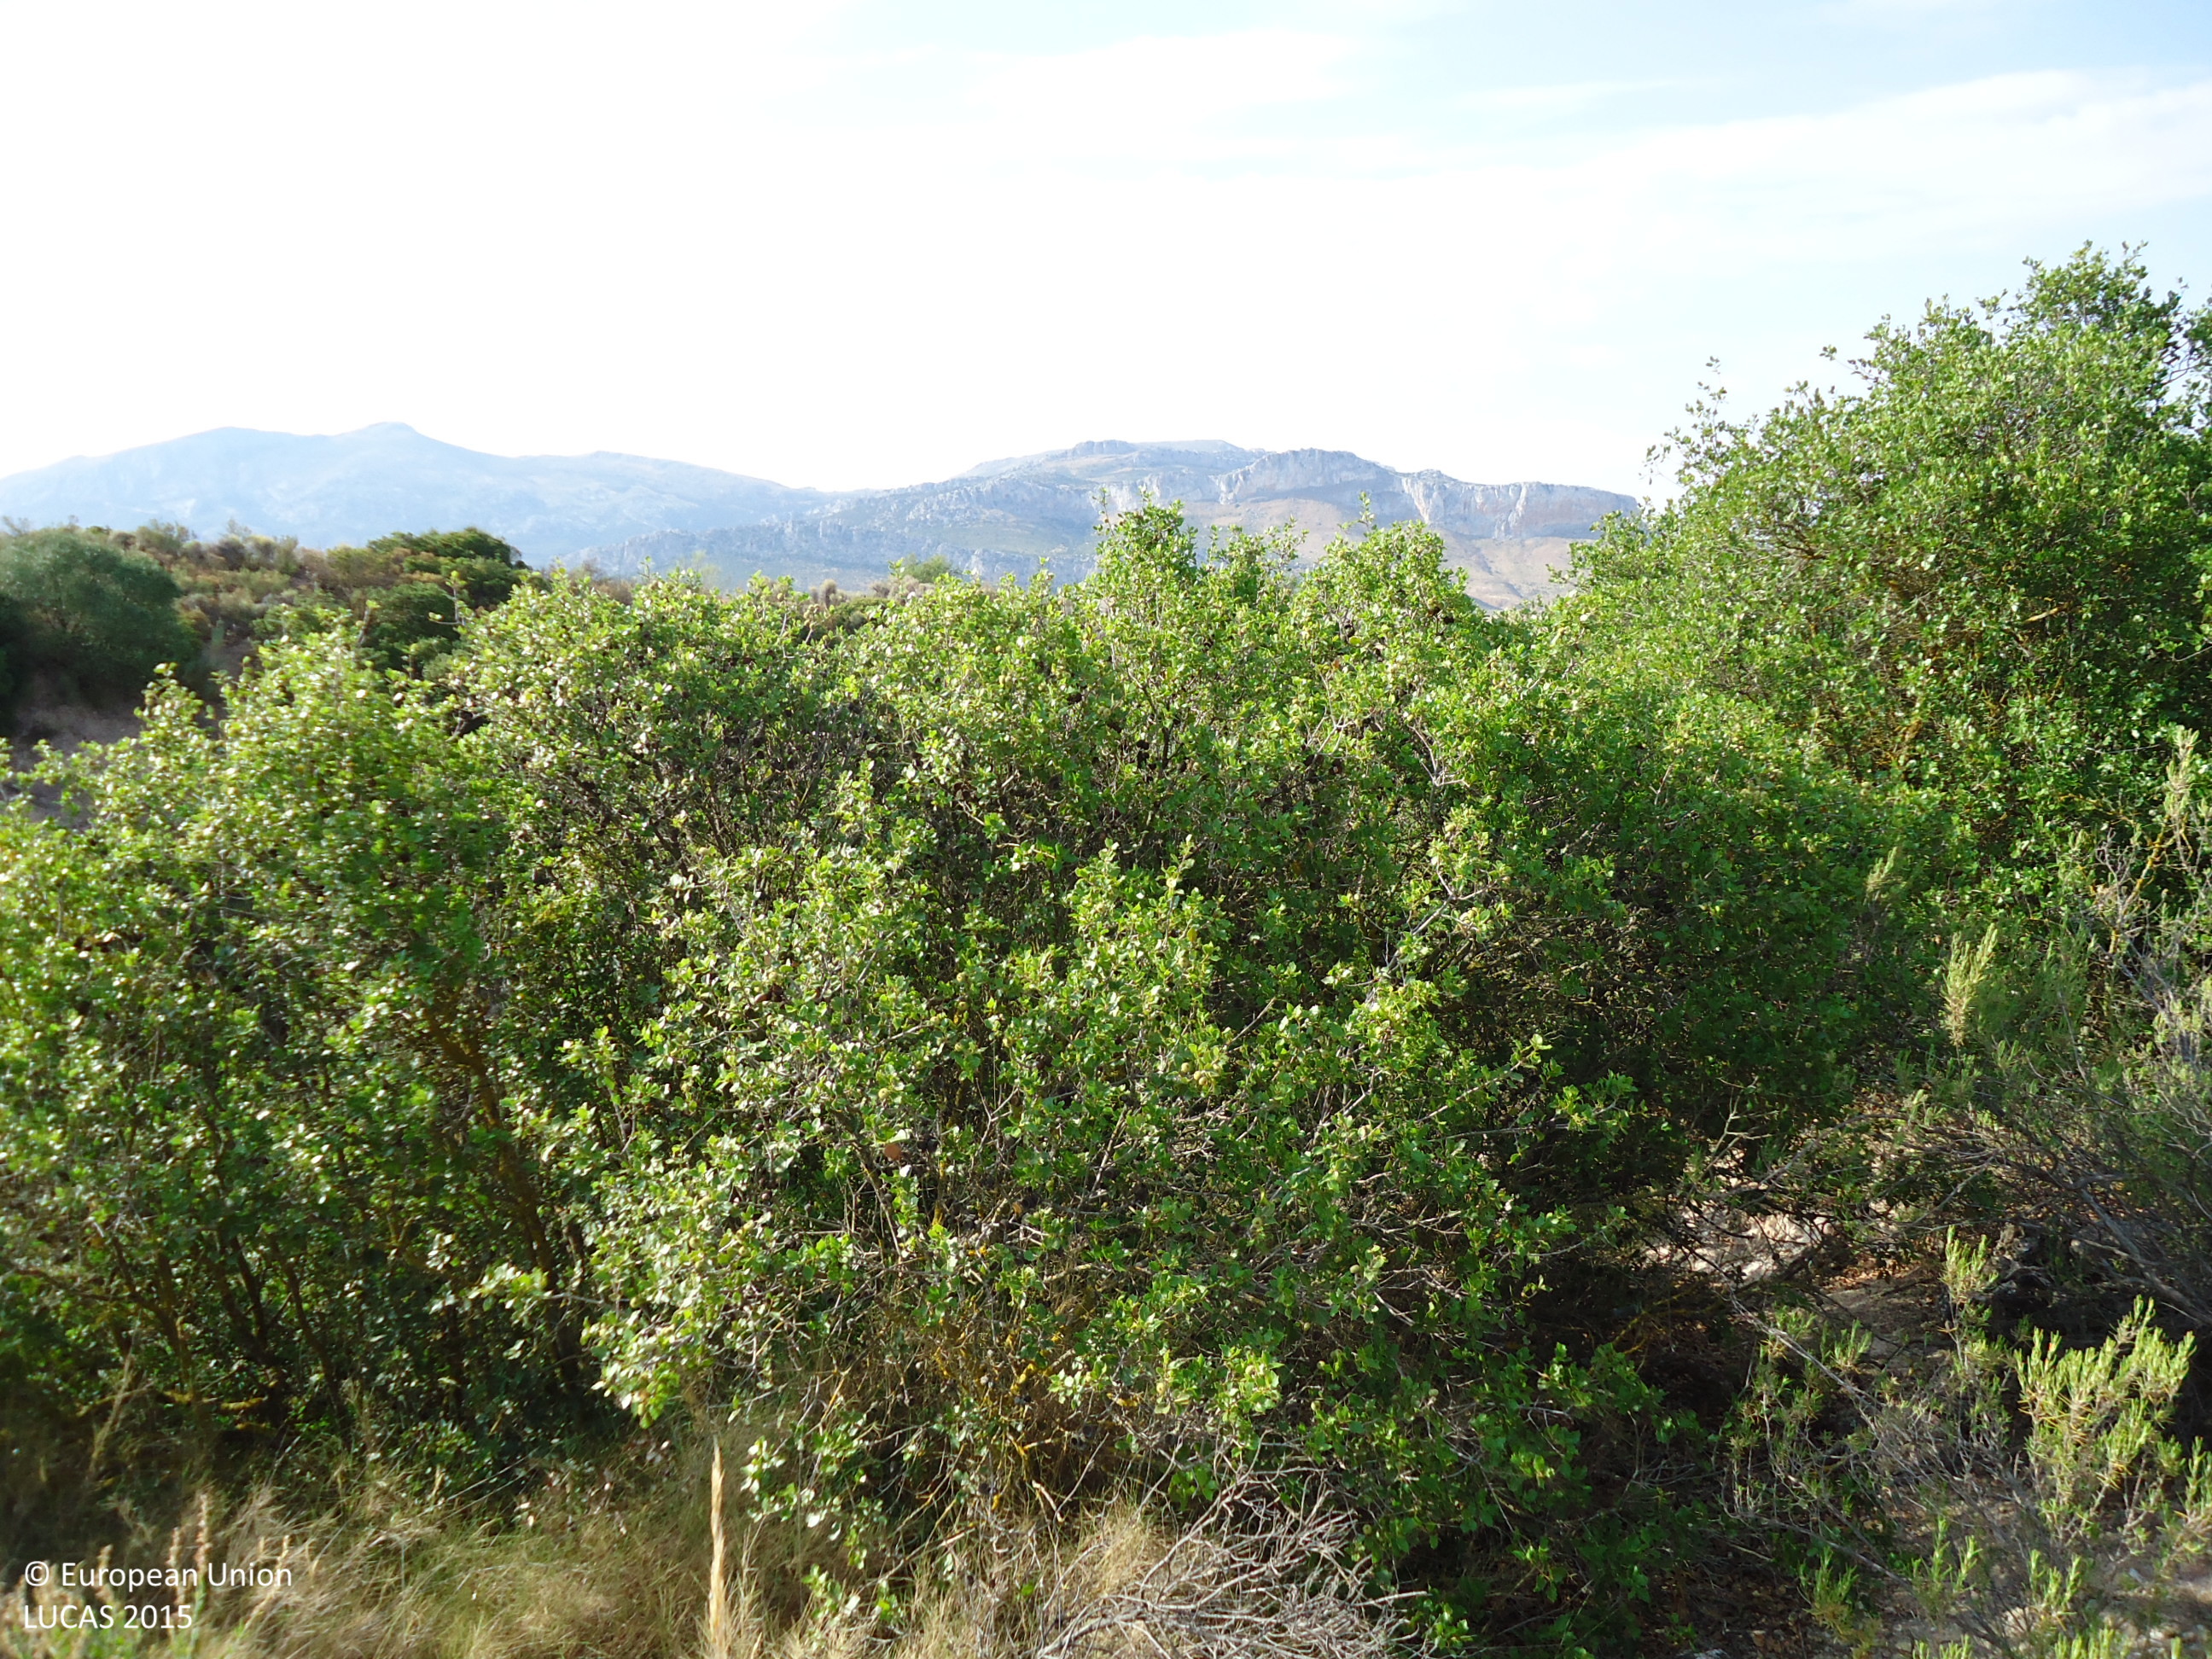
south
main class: Shrubland
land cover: Shrubland without tree cover
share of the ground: > 75 %
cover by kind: shrubs 85 %, herbaceous plants 5 %, consolidated bare surface 5 %, unconsolidated bare surface 5 %
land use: Semi-natural and natural areas not in use
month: June
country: ES
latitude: 36.9915
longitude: -4.7738
